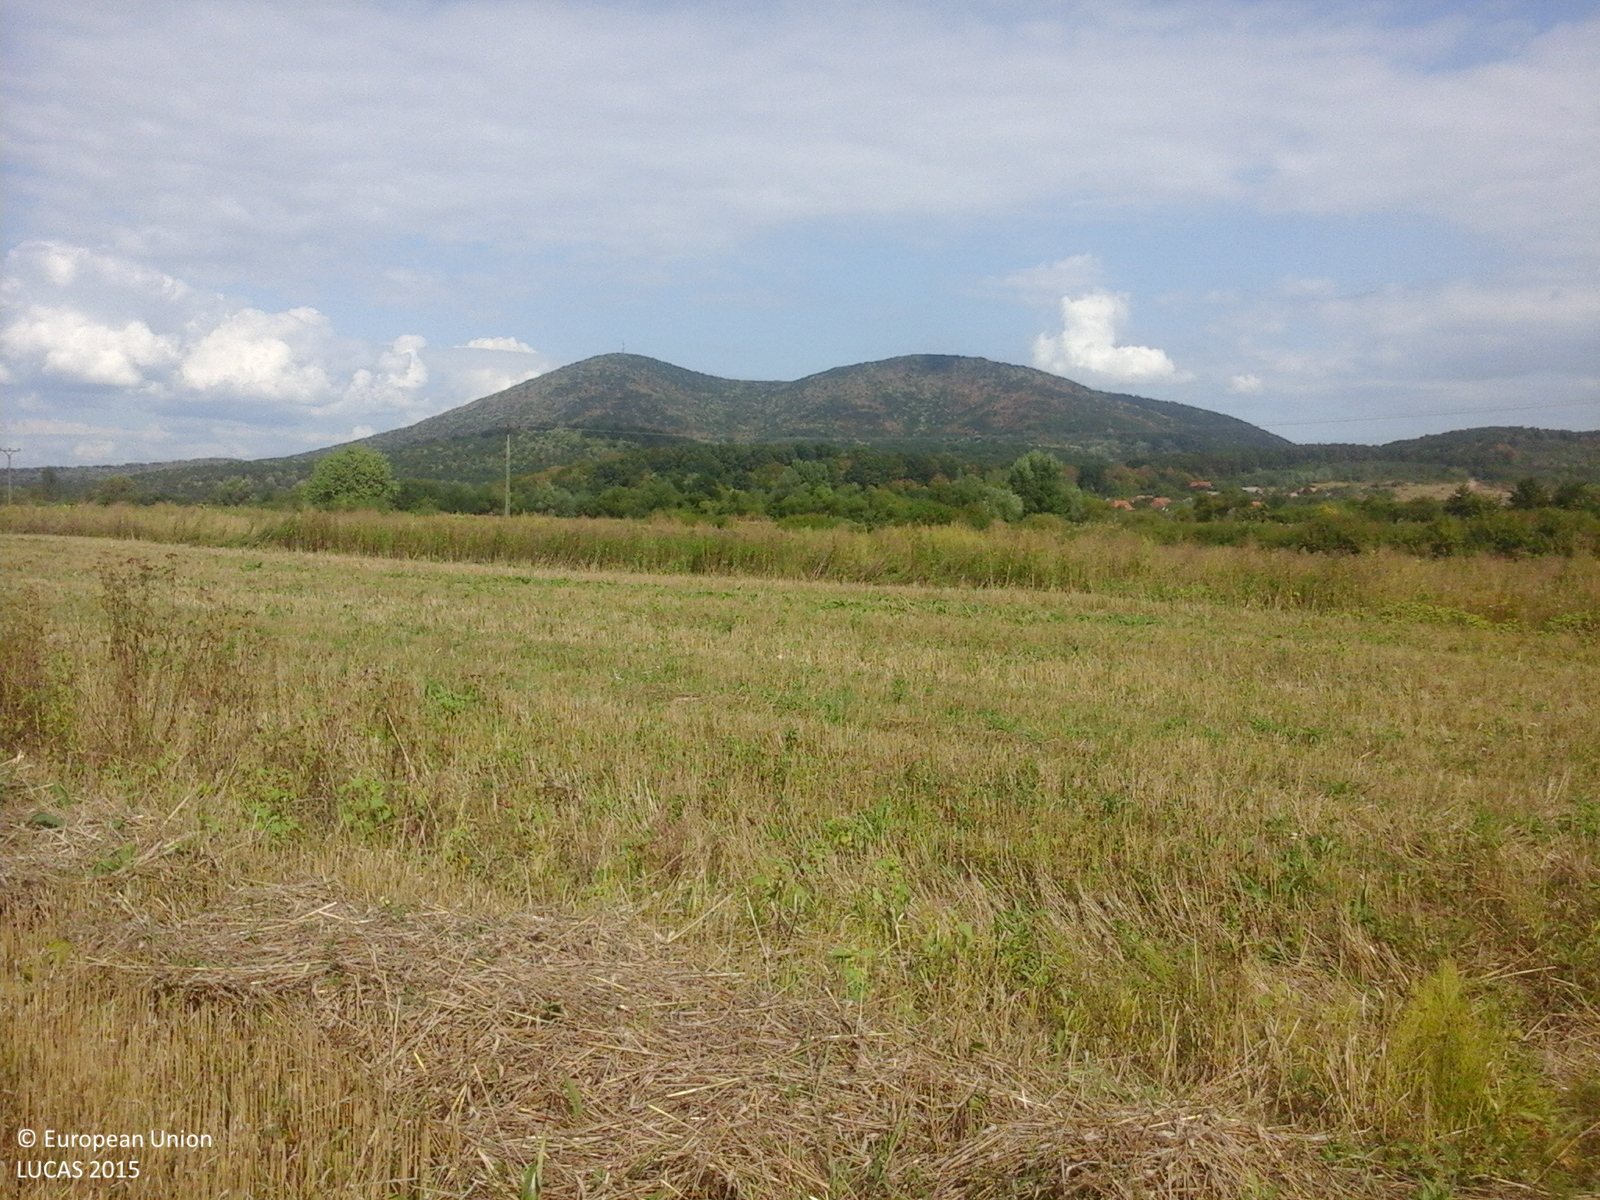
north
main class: Cropland
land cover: Common wheat
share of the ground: > 75 %
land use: Agriculture (excluding fallow land and kitchen gardens)
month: September
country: RO
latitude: 47.8554
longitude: 23.2632
